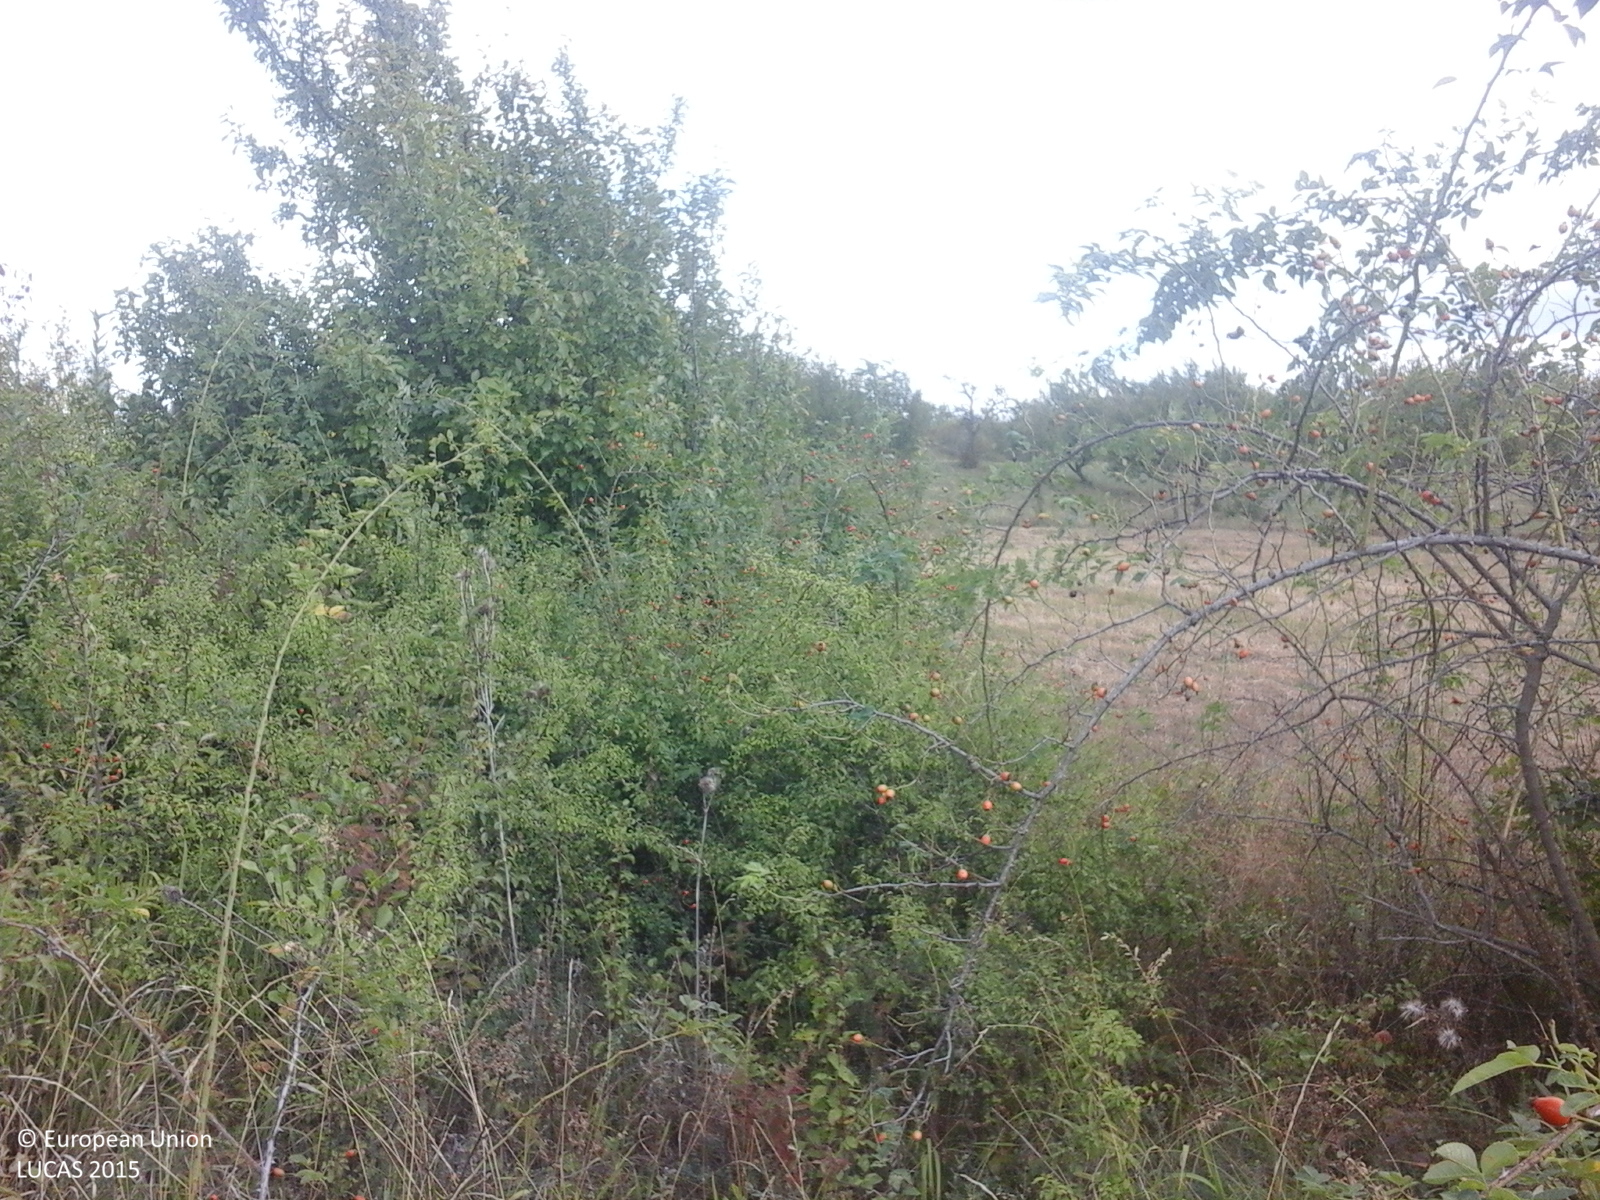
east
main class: Shrubland
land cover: Shrubland without tree cover
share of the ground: > 75 %
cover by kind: shrubs 100 %
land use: Fallow land
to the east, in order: Shrubland without tree cover; Grassland without tree/shrub cover; Apple fruit; Abandoned hedges; Grassland without tree/shrub cover; Other fruit trees and berries; Grassland with sparse tree/shrub cover; Grassland without tree/shrub cover; Maize; Apple fruit; Tracks; Grassland without tree/shrub cover
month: September
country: RO
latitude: 47.4665
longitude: 23.4591
